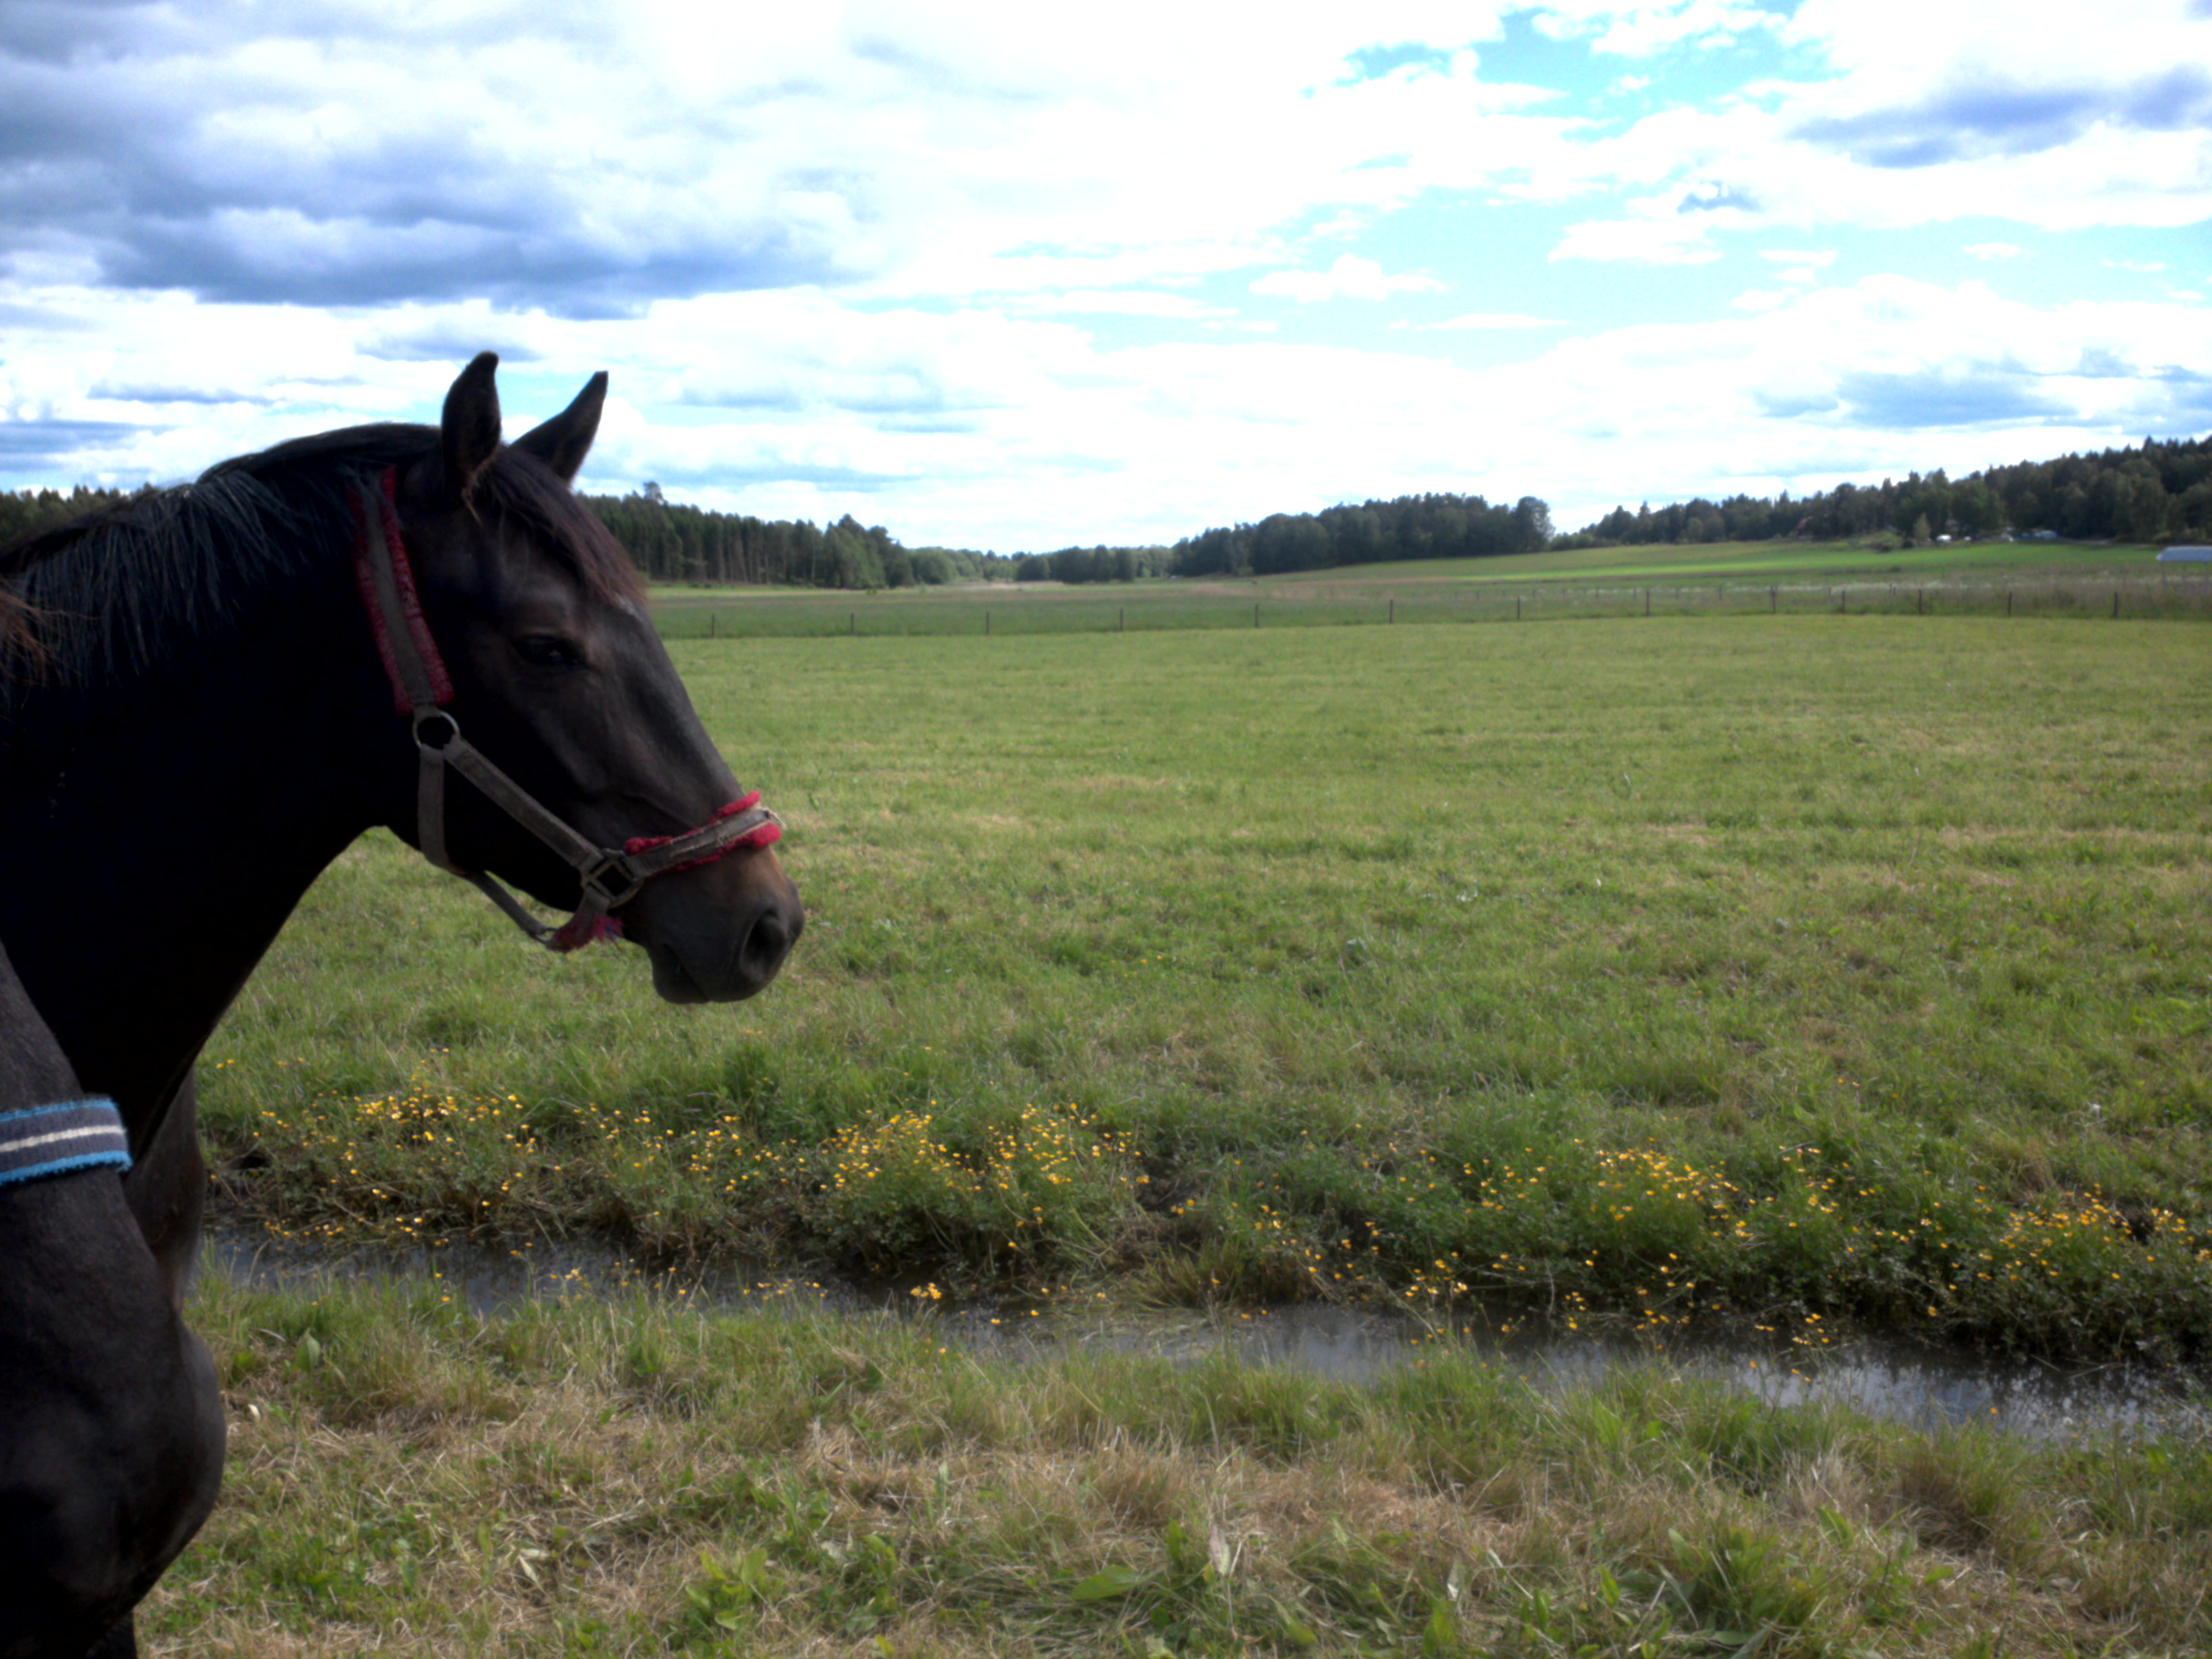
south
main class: Grassland
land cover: Grassland without tree/shrub cover
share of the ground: > 75 %
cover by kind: herbaceous plants 100 %
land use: Agriculture (excluding fallow land and kitchen gardens)
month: June
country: SE
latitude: 59.3796
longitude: 17.5826
